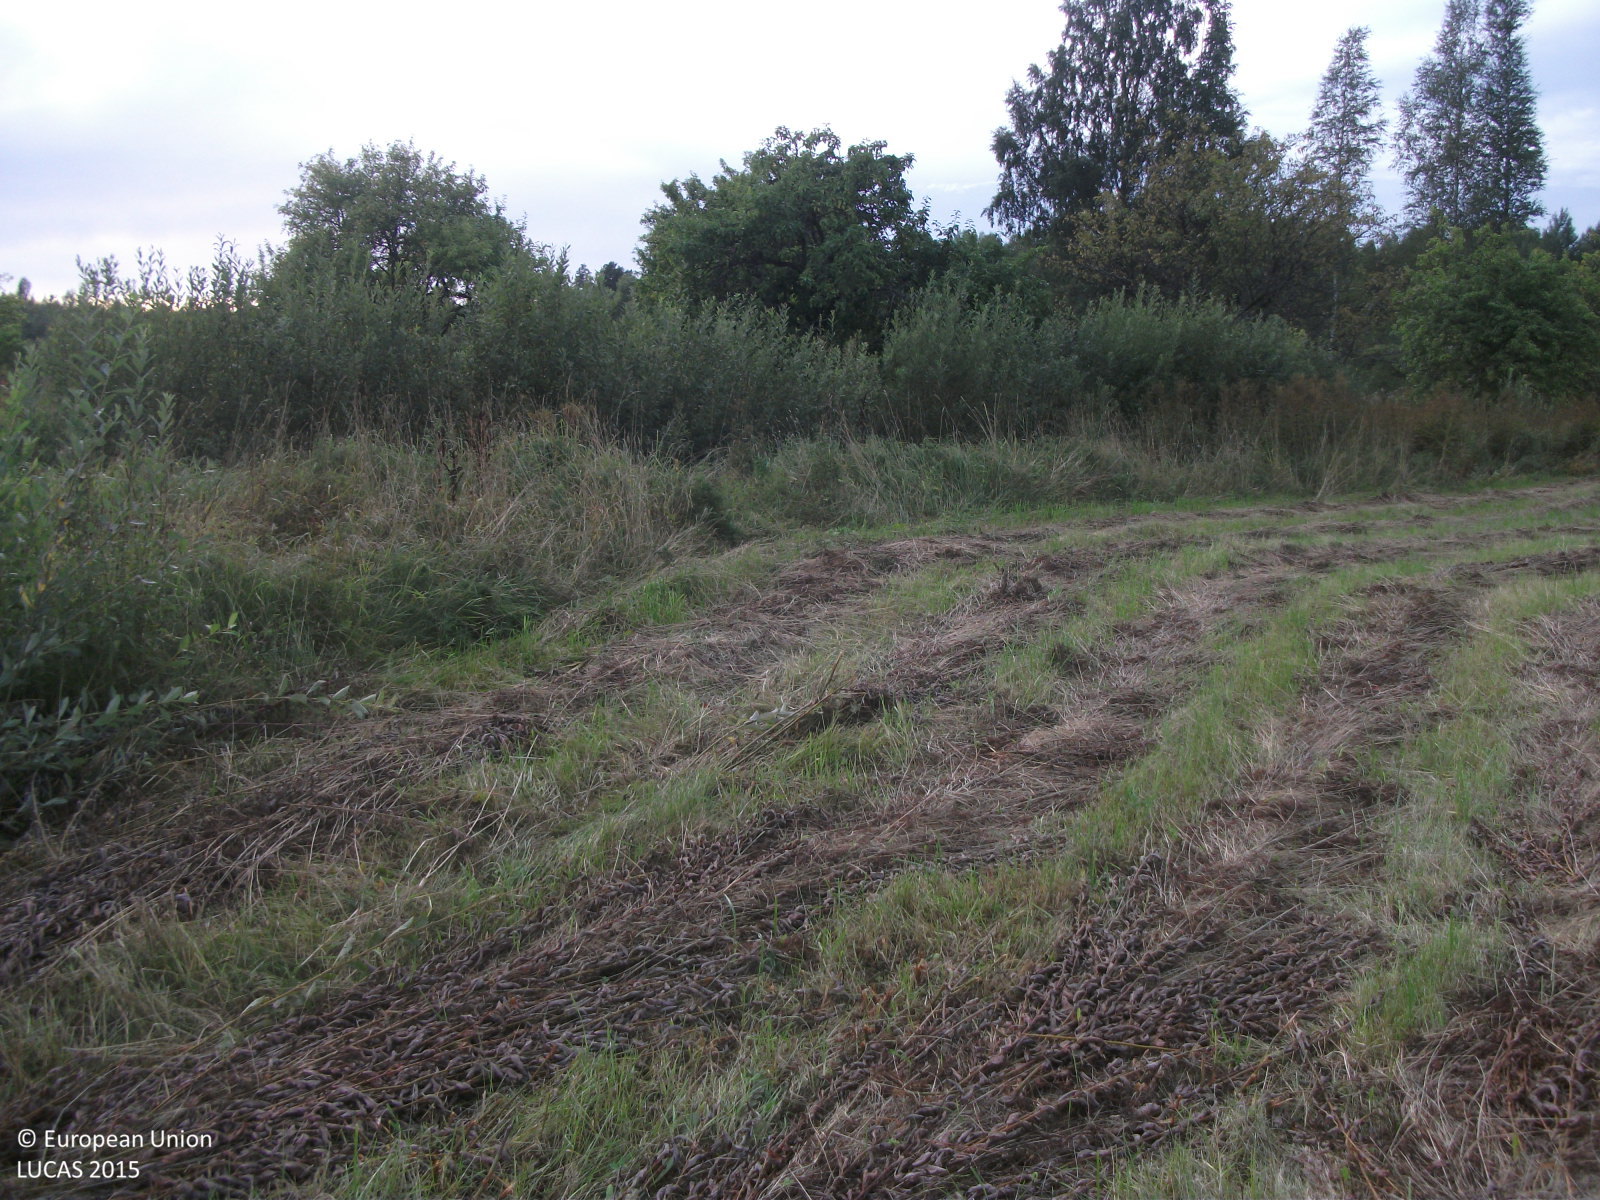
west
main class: Grassland
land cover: Grassland without tree/shrub cover
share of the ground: > 75 %
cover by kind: herbaceous plants 100 %
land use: Agriculture (excluding fallow land and kitchen gardens)
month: September
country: LV
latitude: 57.6547
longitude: 24.7595
